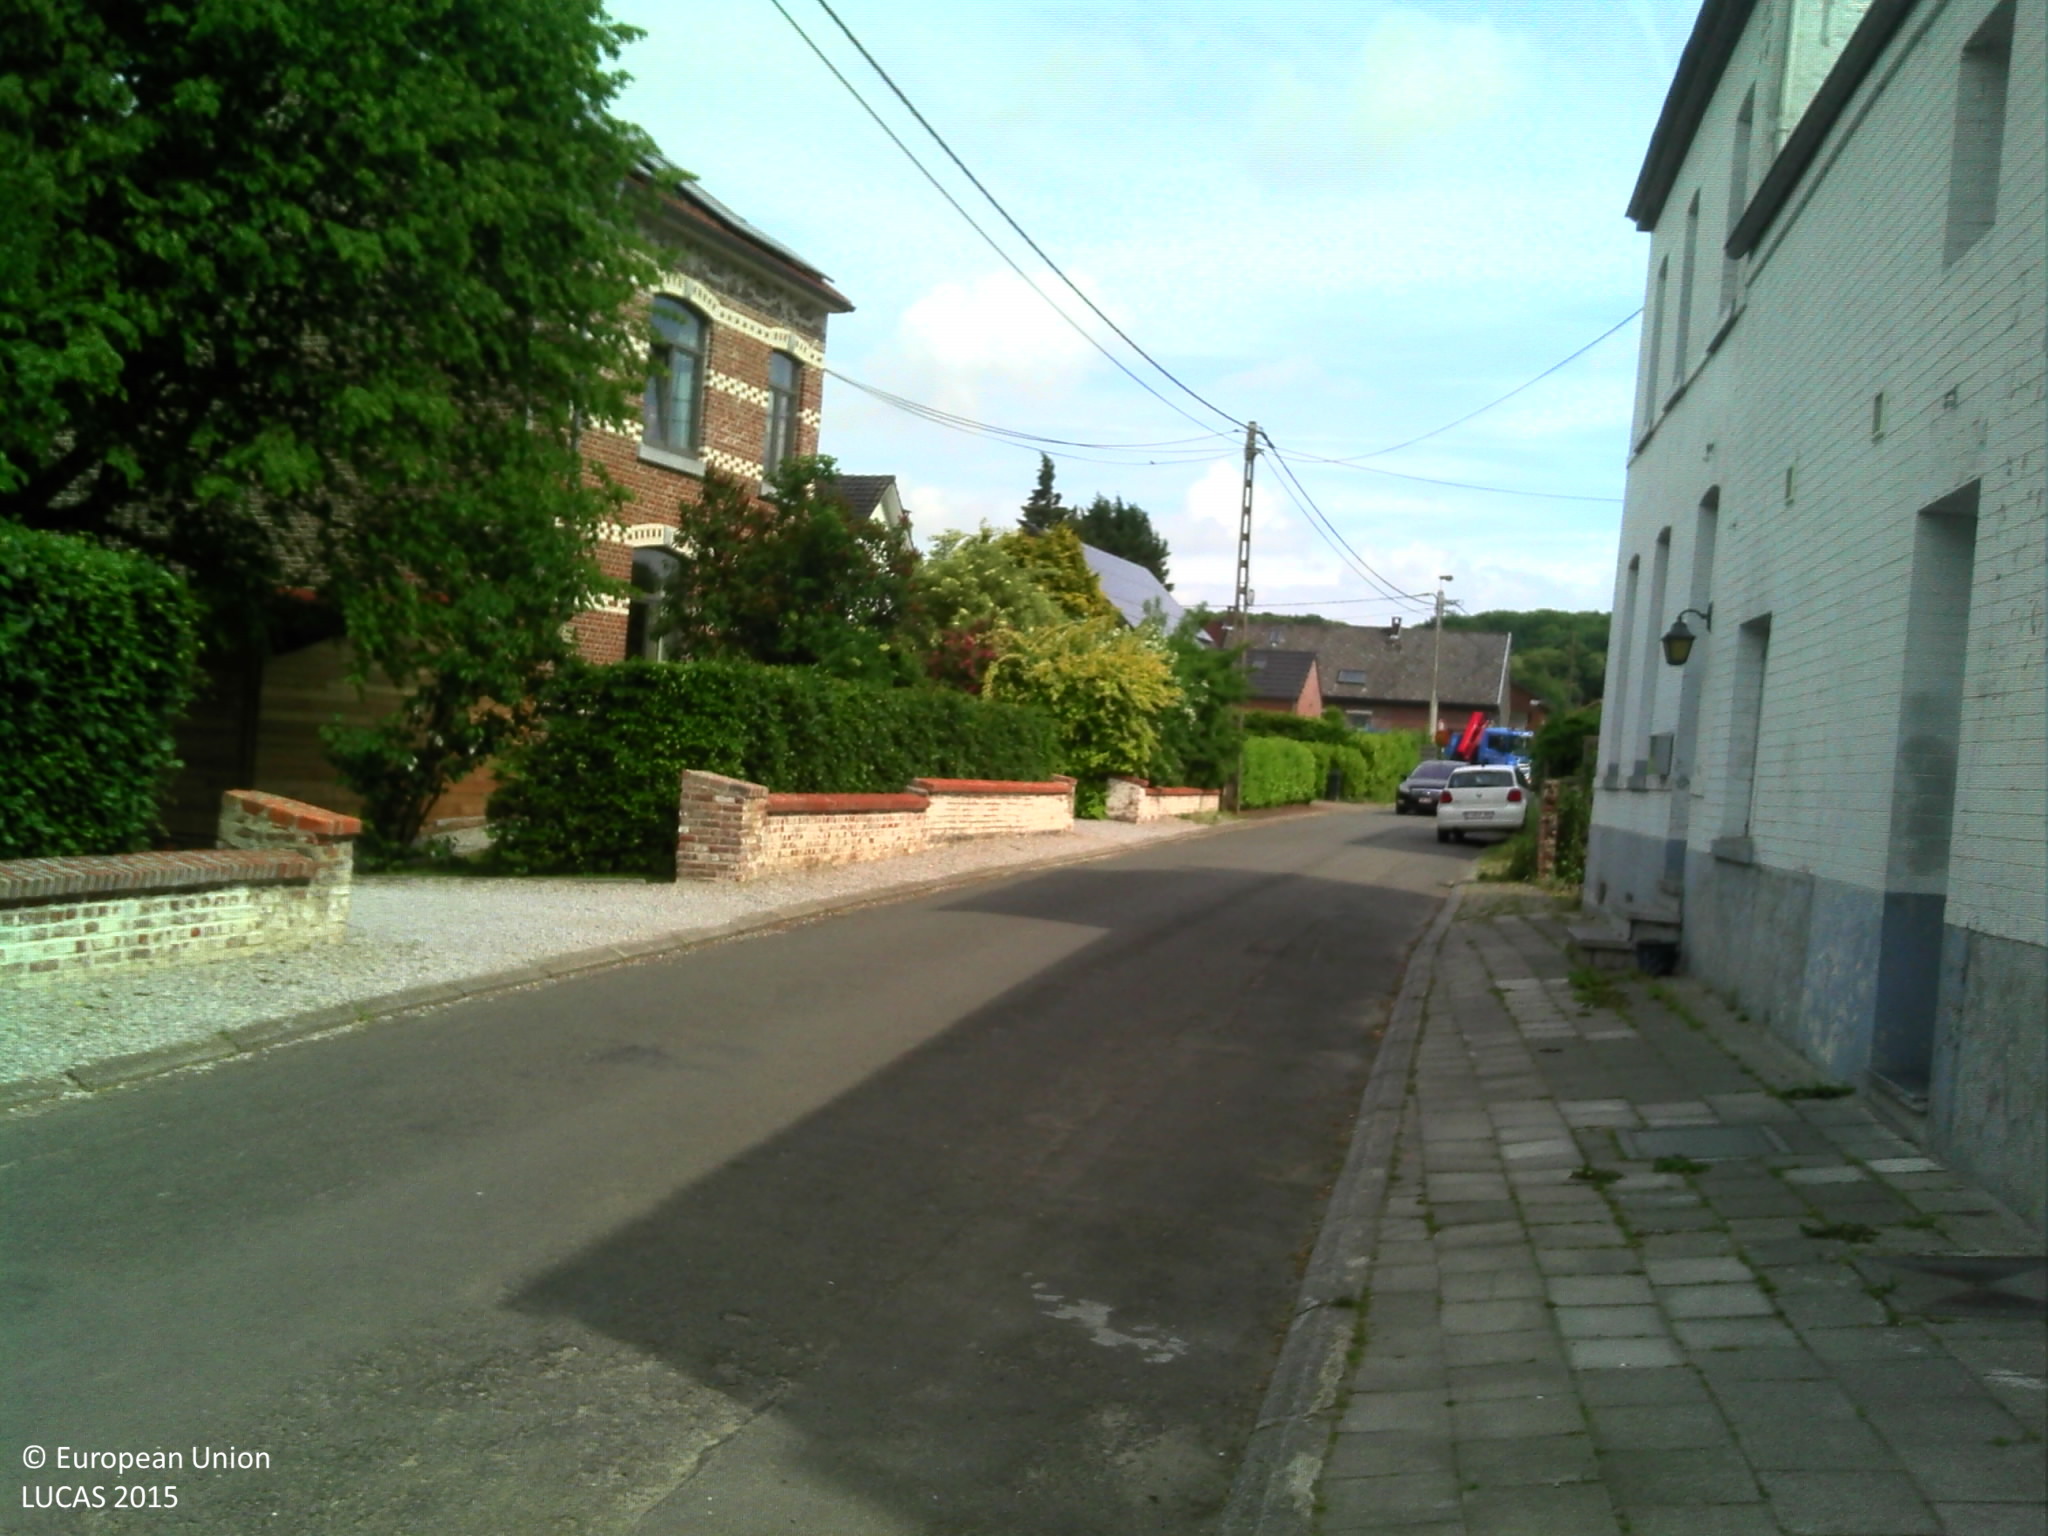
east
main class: Grassland
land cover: Grassland with sparse tree/shrub cover
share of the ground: > 75 %
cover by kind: herbaceous plants 95 %, broadleaved forest trees 5 %
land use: Residential
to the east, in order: Grassland with sparse tree/shrub cover; Artificial constructions in urban areas
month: May
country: BE
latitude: 50.7808
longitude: 4.6777
